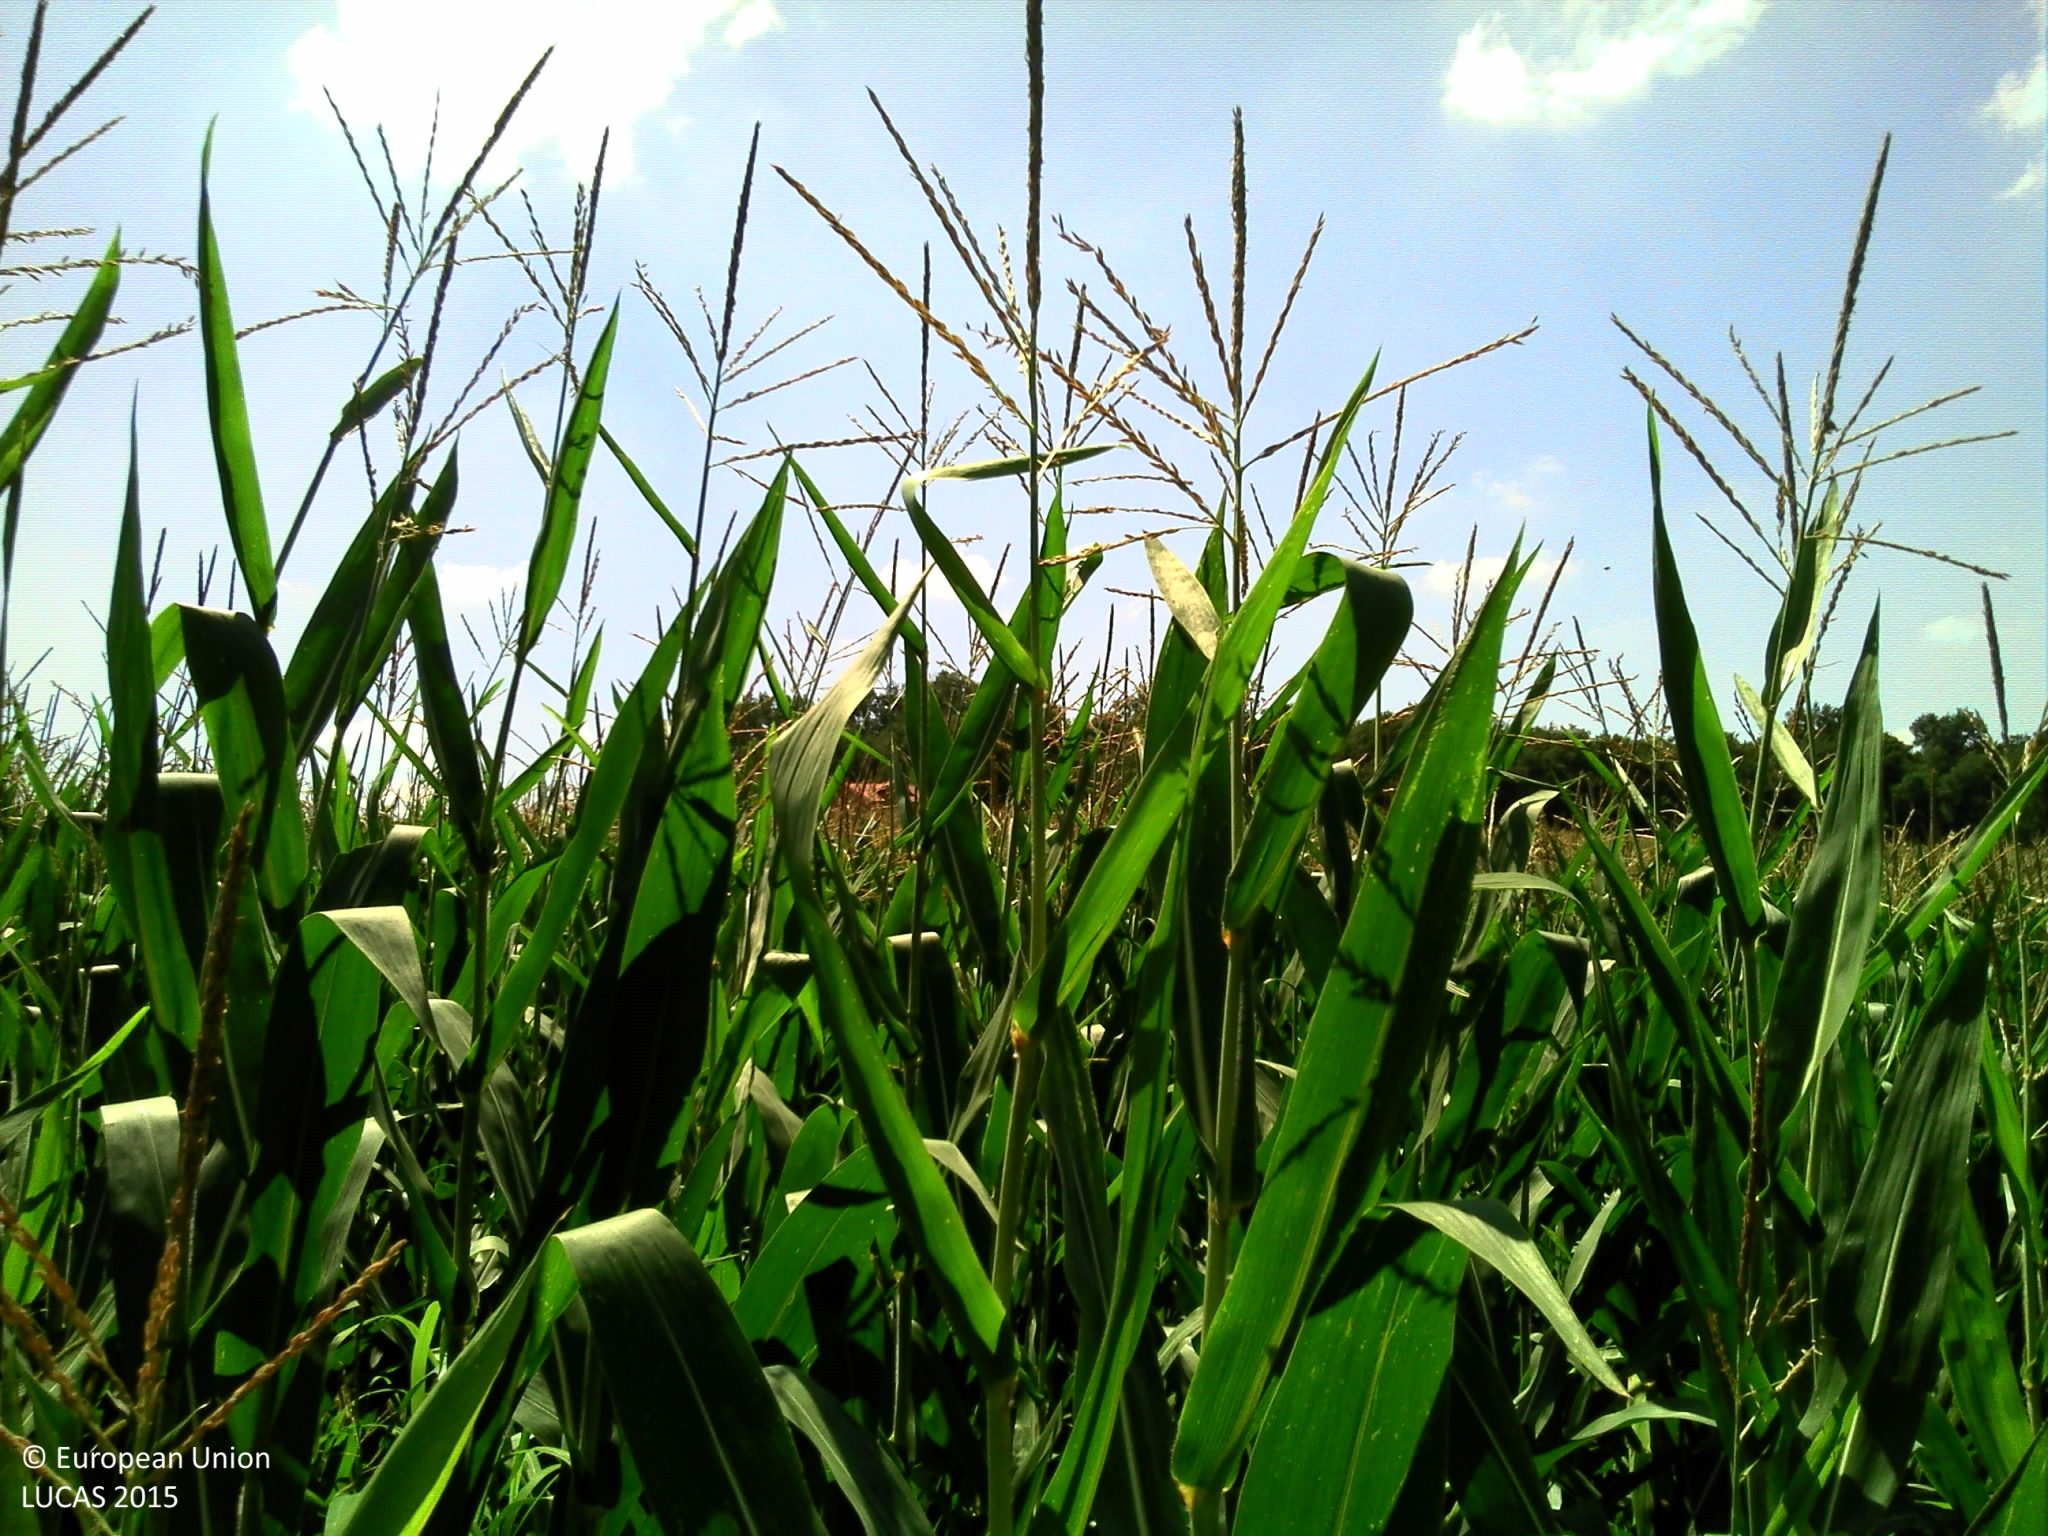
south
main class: Cropland
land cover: Maize
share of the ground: > 75 %
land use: Agriculture (excluding fallow land and kitchen gardens)
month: August
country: FR
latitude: 43.7076
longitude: -0.4972
